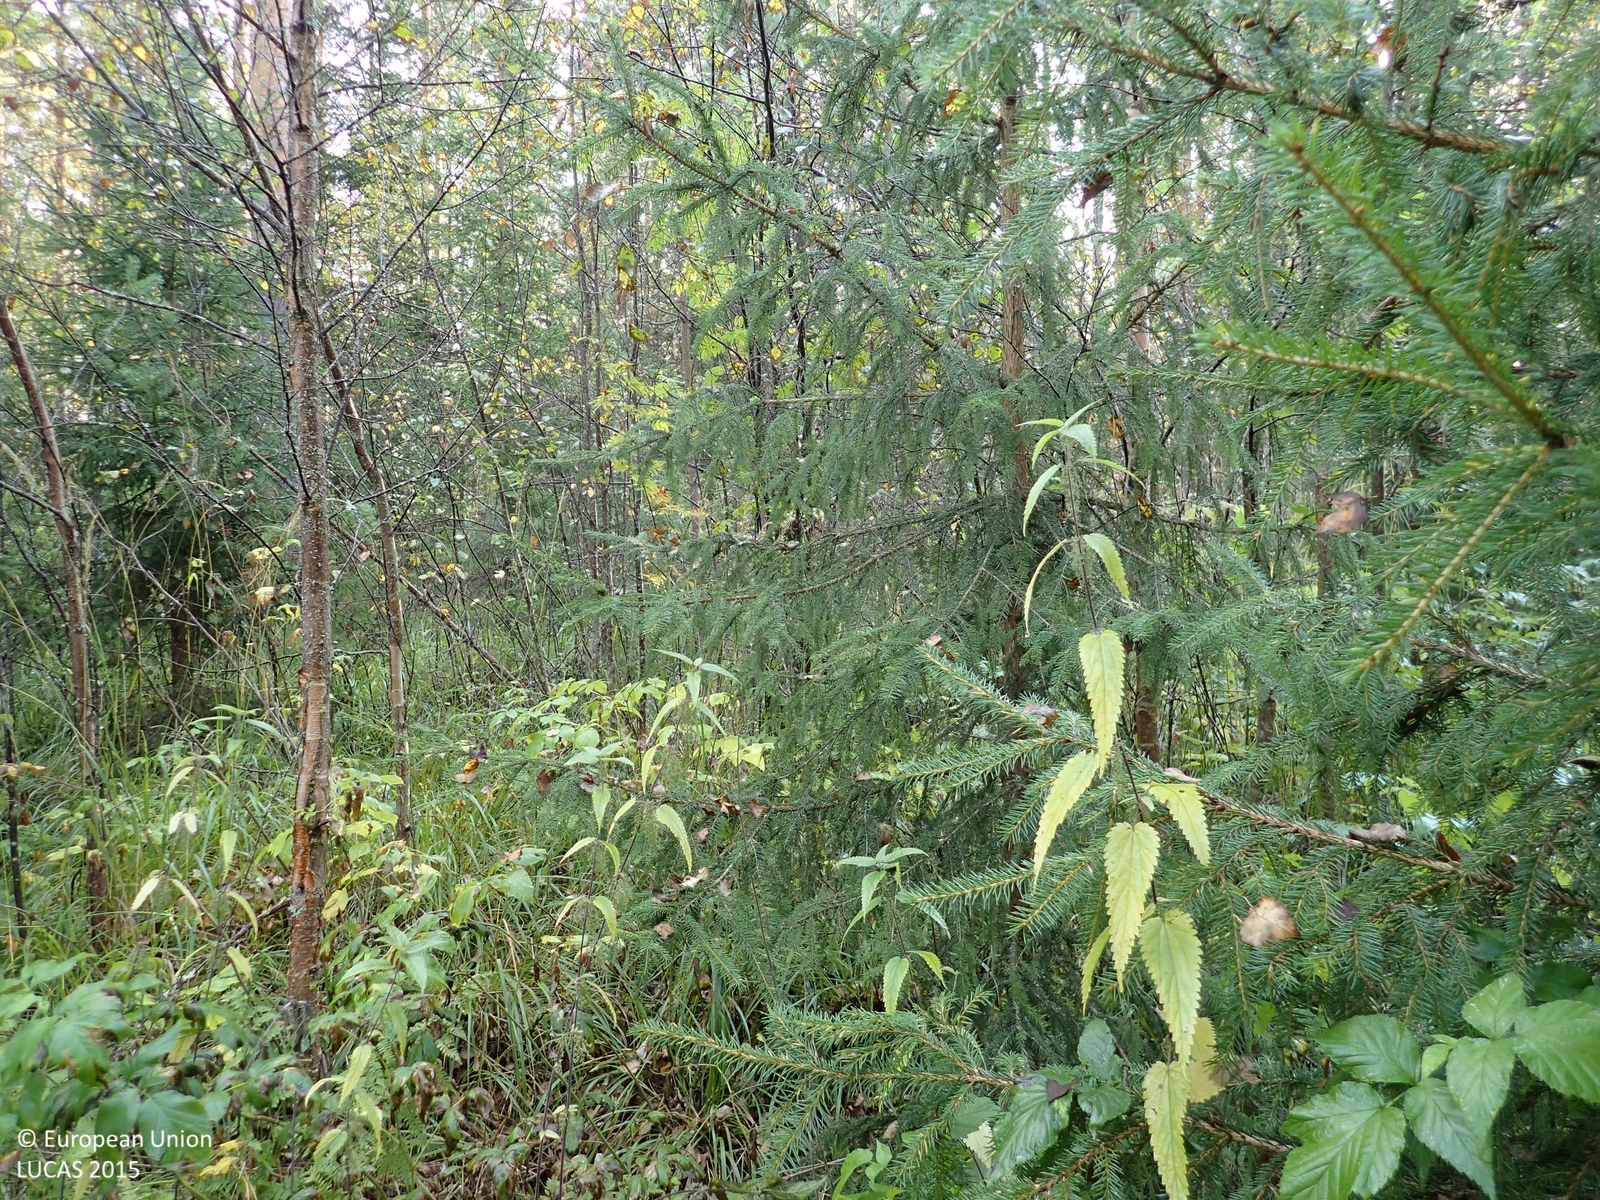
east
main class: Woodland
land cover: Spruce dominated mixed woodland
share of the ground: > 75 %
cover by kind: coniferous forest trees 55 %, herbaceous plants 25 %, broadleaved forest trees 20 %
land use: Forestry
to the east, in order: Spruce dominated mixed woodland; Pine dominated mixed woodland; Ditches and canals; Grass margins; Paved roads, cycling and walking lanes; Grass margins; Ditches and canals; Grassland with sparse tree/shrub cover; Pine dominated coniferous woodland
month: September
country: FI
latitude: 63.0125
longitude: 25.5742
